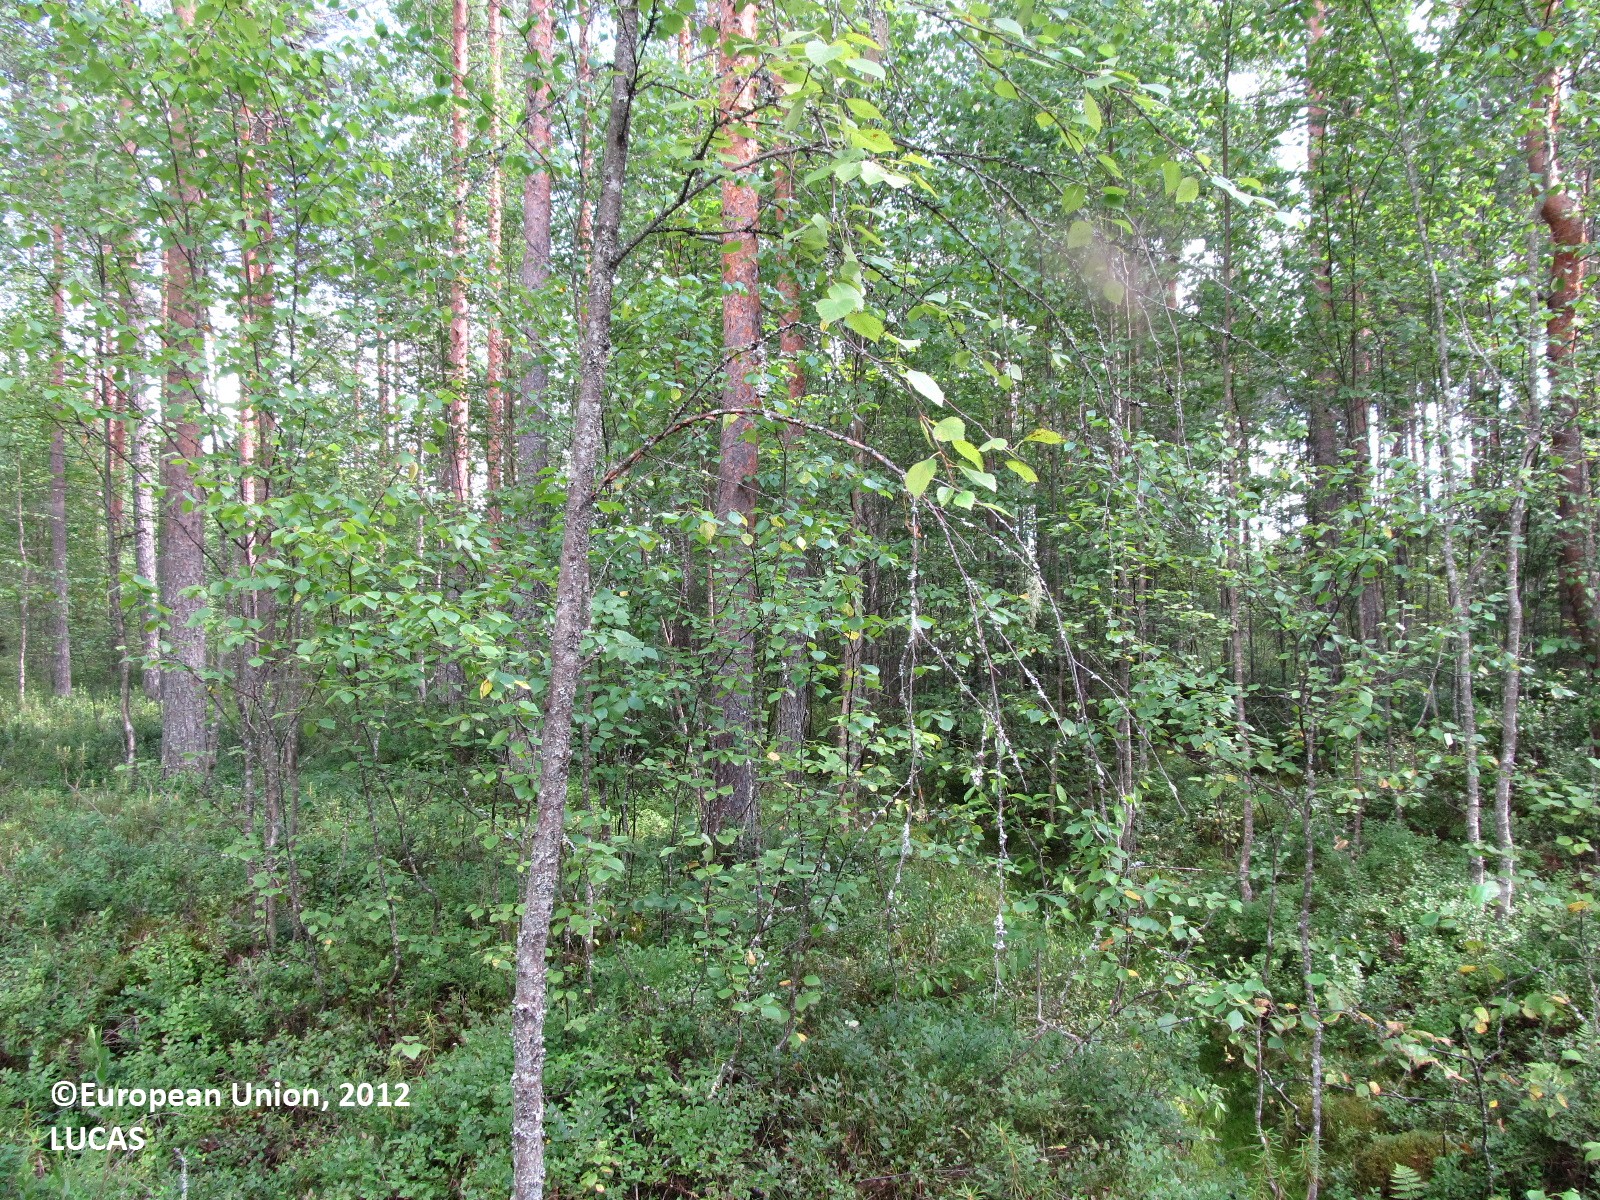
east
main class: Woodland
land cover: Pine dominated mixed woodland
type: boreal forest
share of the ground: 25 - 50 %
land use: Forestry
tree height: > 5 m
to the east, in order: Pine dominated mixed woodland; Ditches and canals; Spruce dominated mixed woodland; Ditches and canals; Spruce dominated mixed woodland; Pine dominated coniferous woodland; Tracks; Pine dominated coniferous woodland
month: July
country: FI
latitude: 61.8178
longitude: 27.9357
